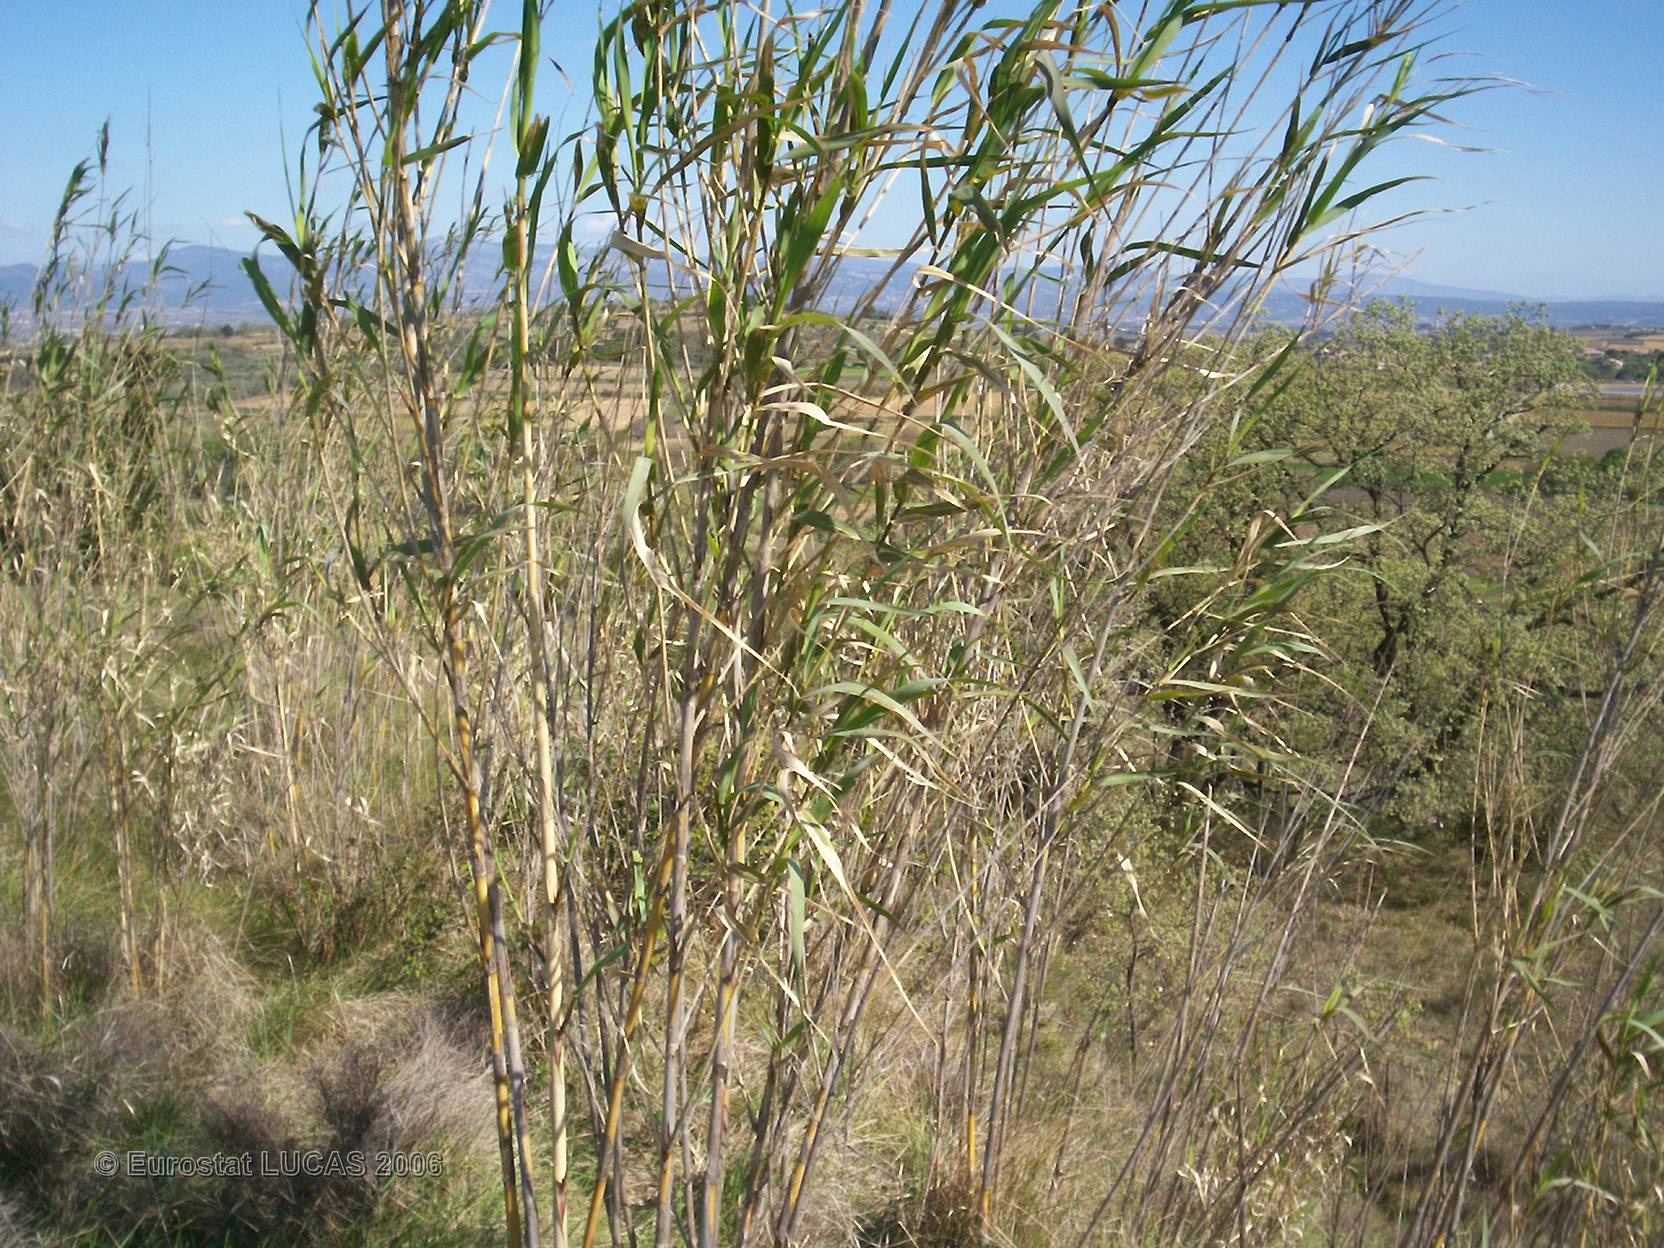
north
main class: Grassland
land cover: Grassland with sparse tree/shrub cover
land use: Unused
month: April
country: FR
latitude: 43.6057
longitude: 3.5293
